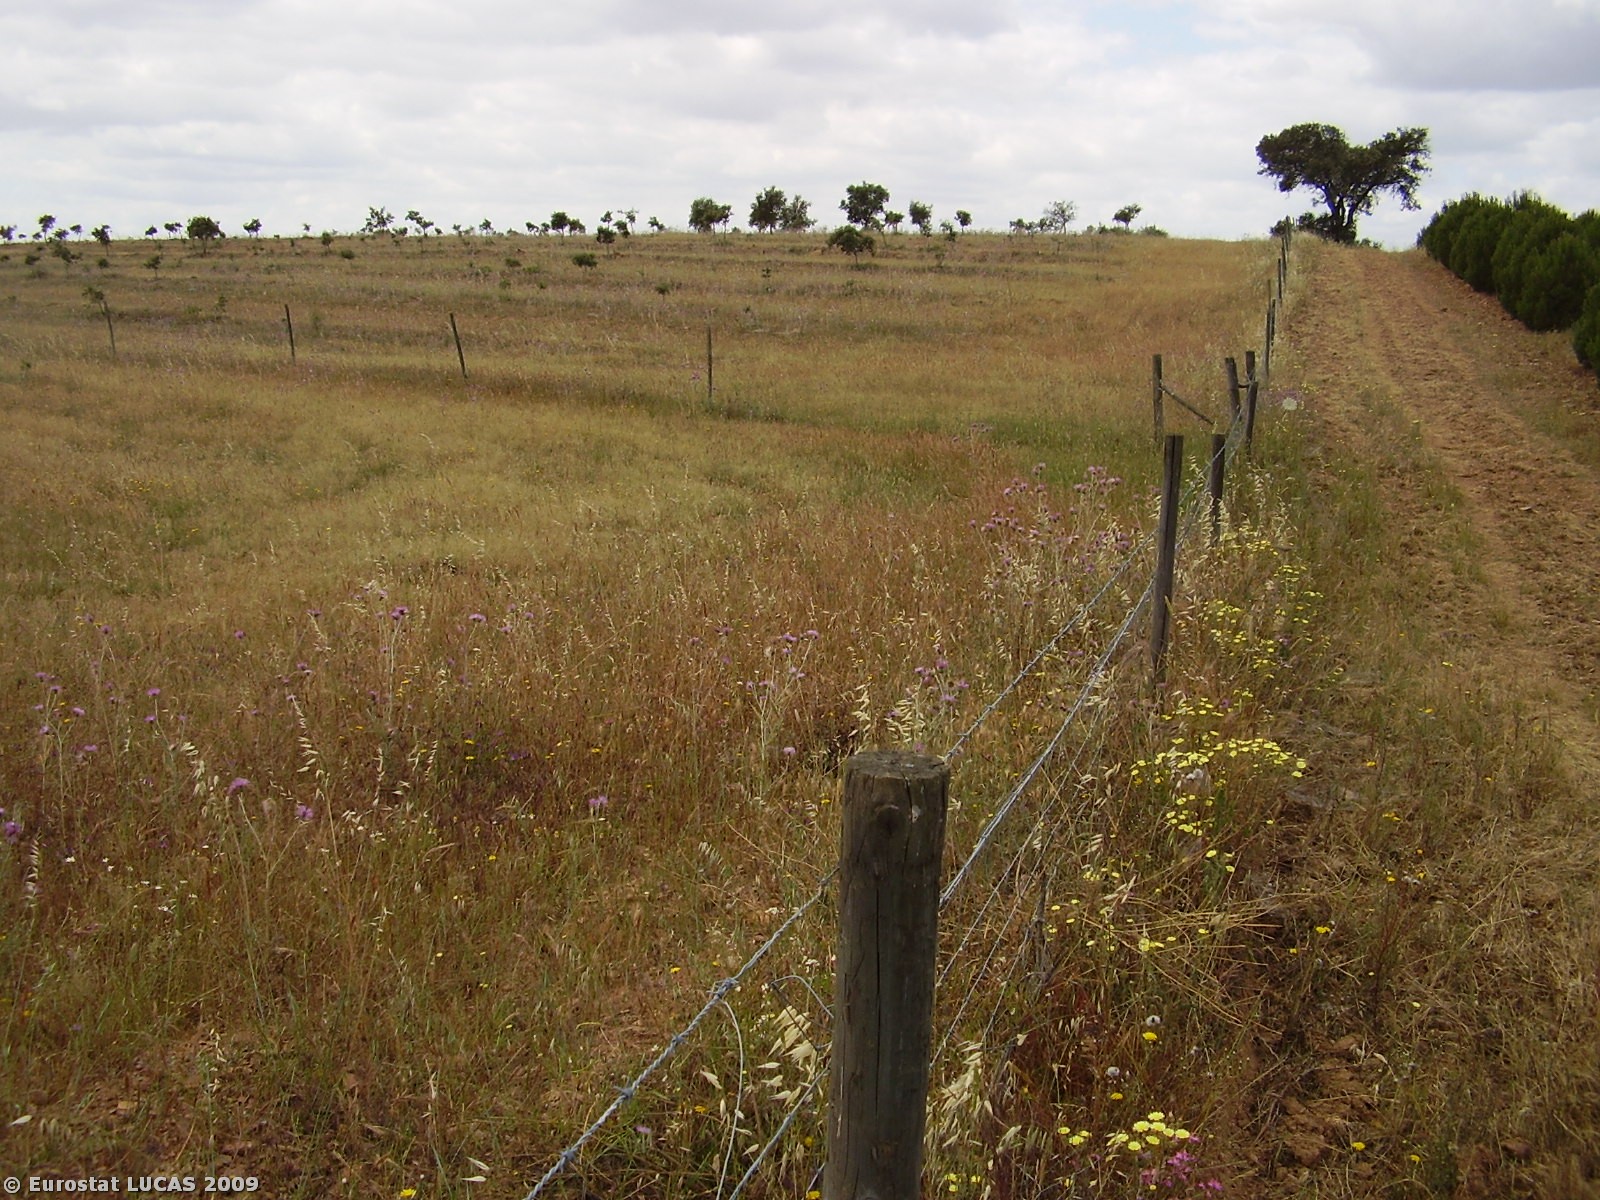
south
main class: Woodland
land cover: Broadleaved woodland
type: broadleaved evergreen forest
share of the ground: 25 - 50 %
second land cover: Spontaneously vegetated surfaces
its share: > 75 %
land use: Forestry
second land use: Fallow land
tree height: > 5 m
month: May
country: PT
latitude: 37.7948
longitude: -7.8874
